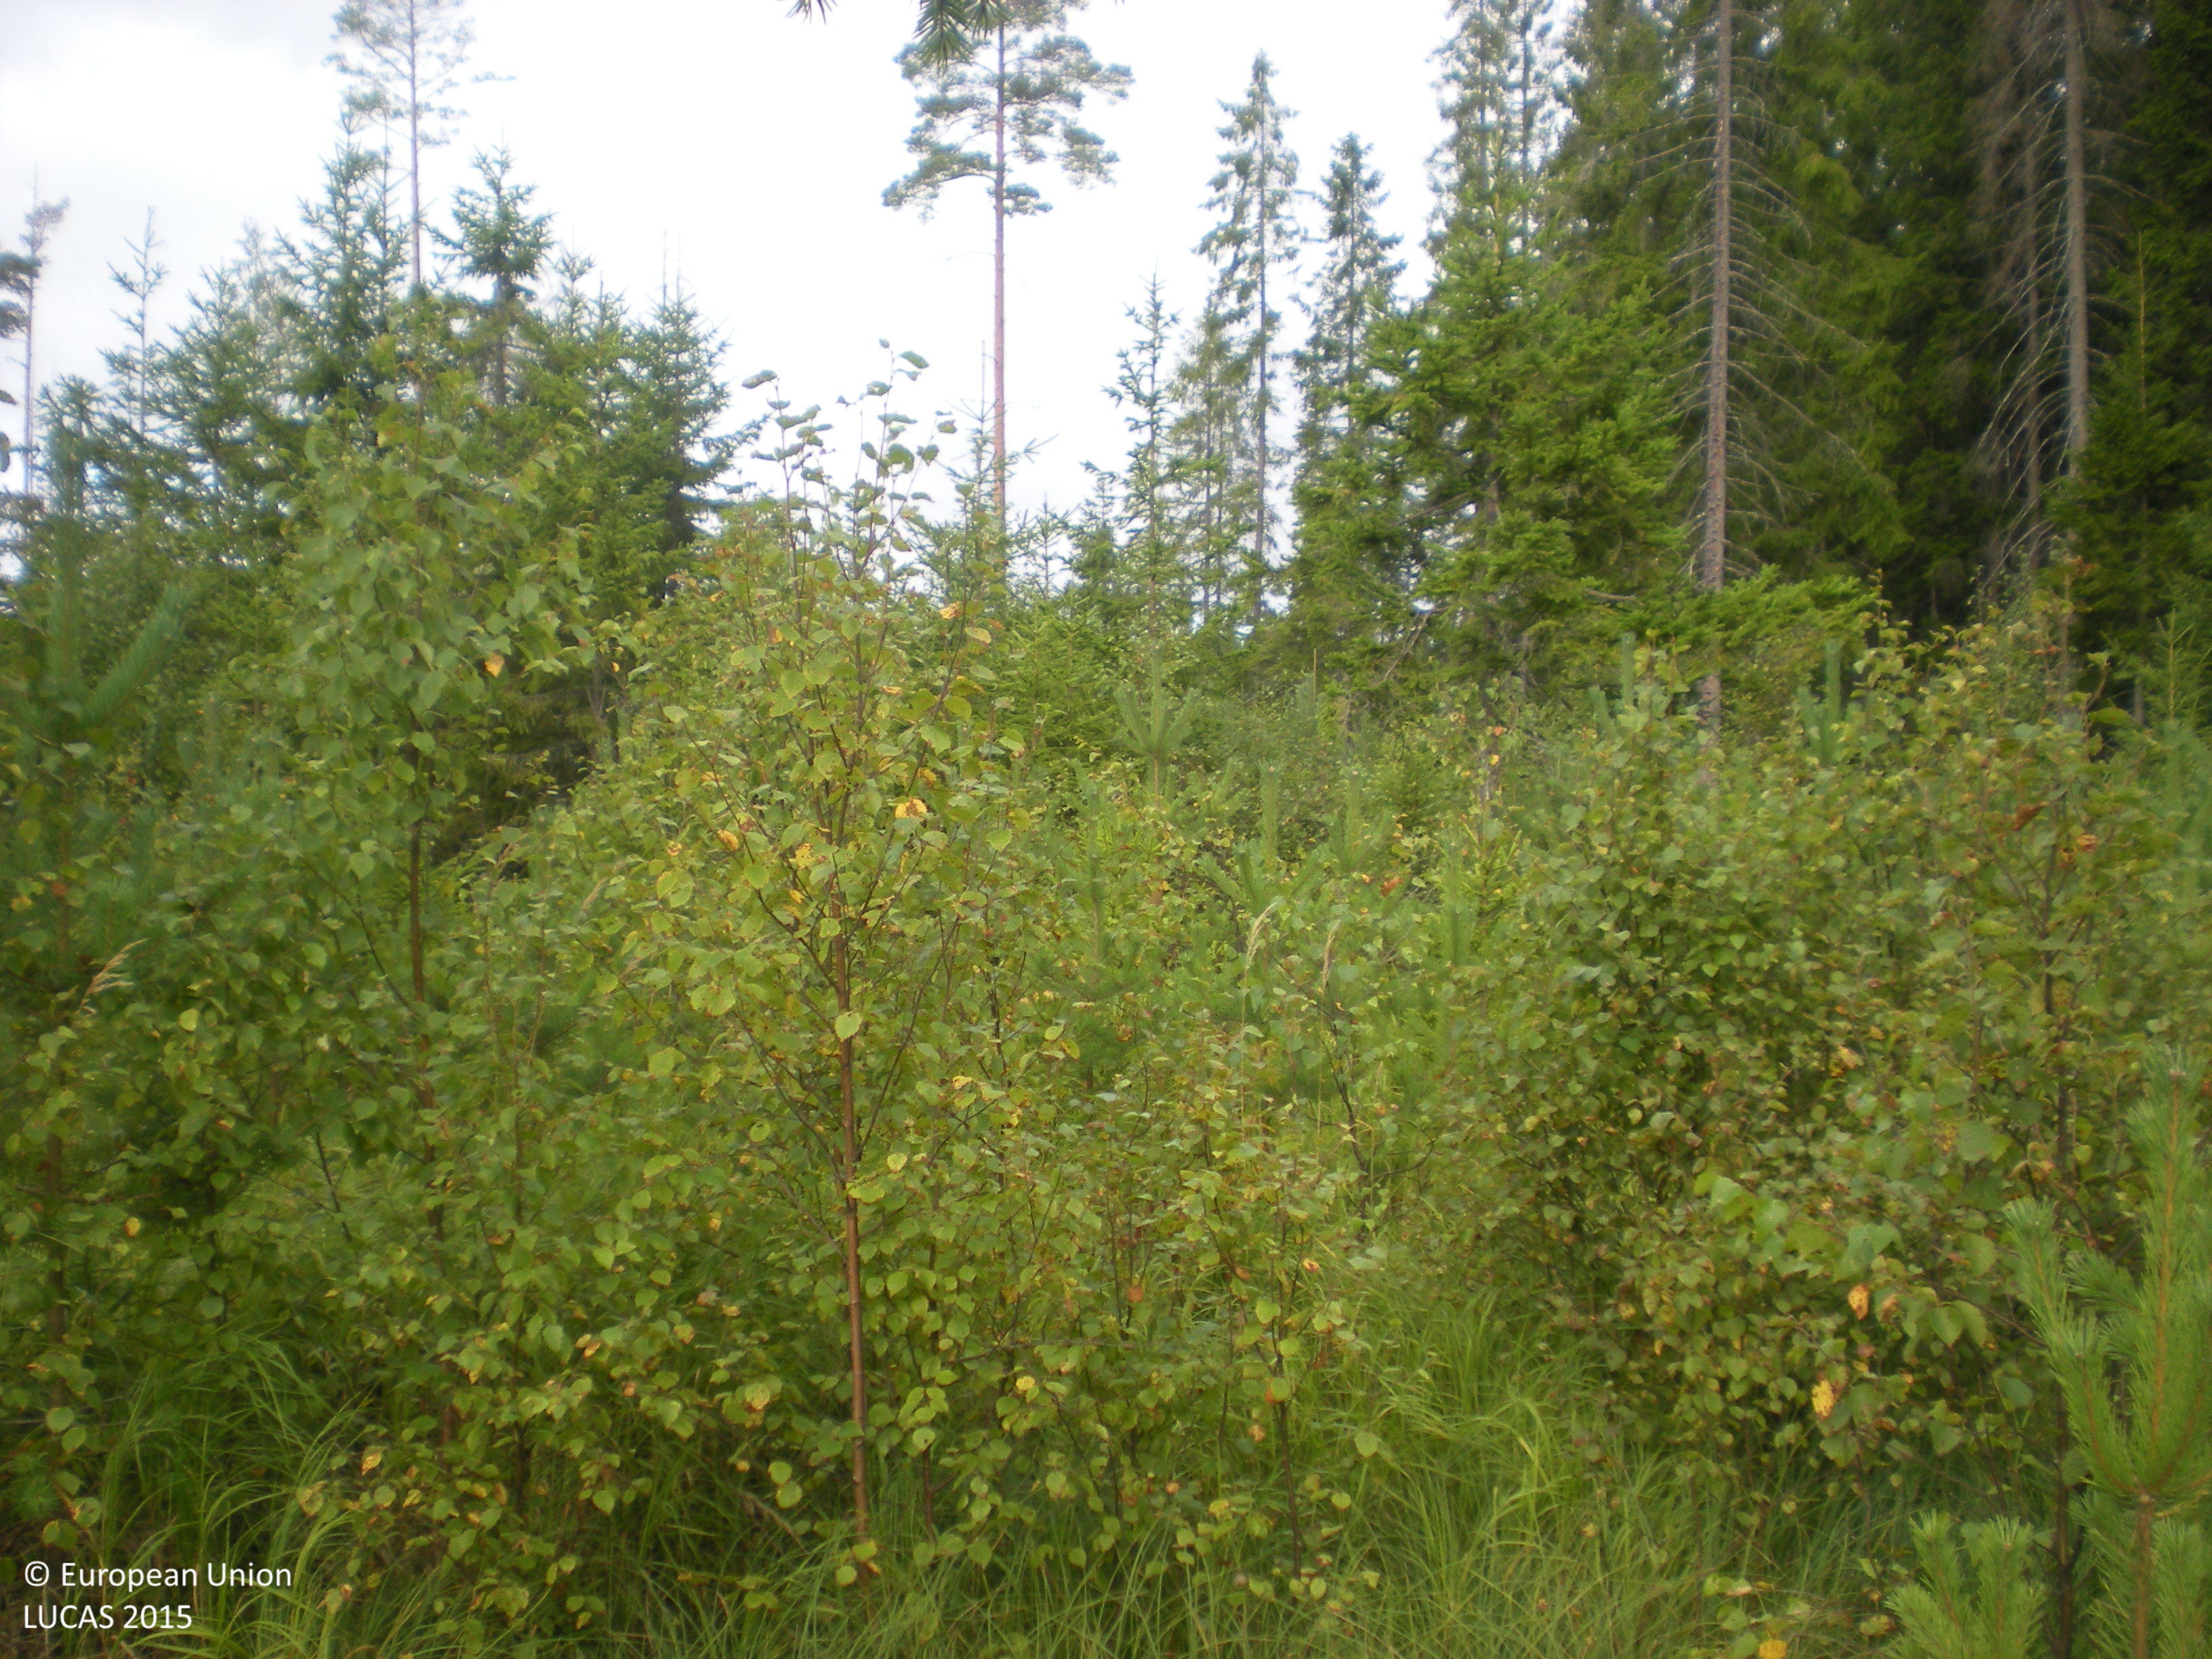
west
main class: Woodland
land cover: Pine dominated mixed woodland
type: boreal forest
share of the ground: 50 - 75 %
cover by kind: coniferous forest trees 35 %, broadleaved forest trees 35 %, herbaceous plants 20 %, shrubs 5 %, lichens and mosses 5 %
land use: Forestry
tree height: < 5 m
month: August
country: SE
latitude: 60.4681
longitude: 16.8096
